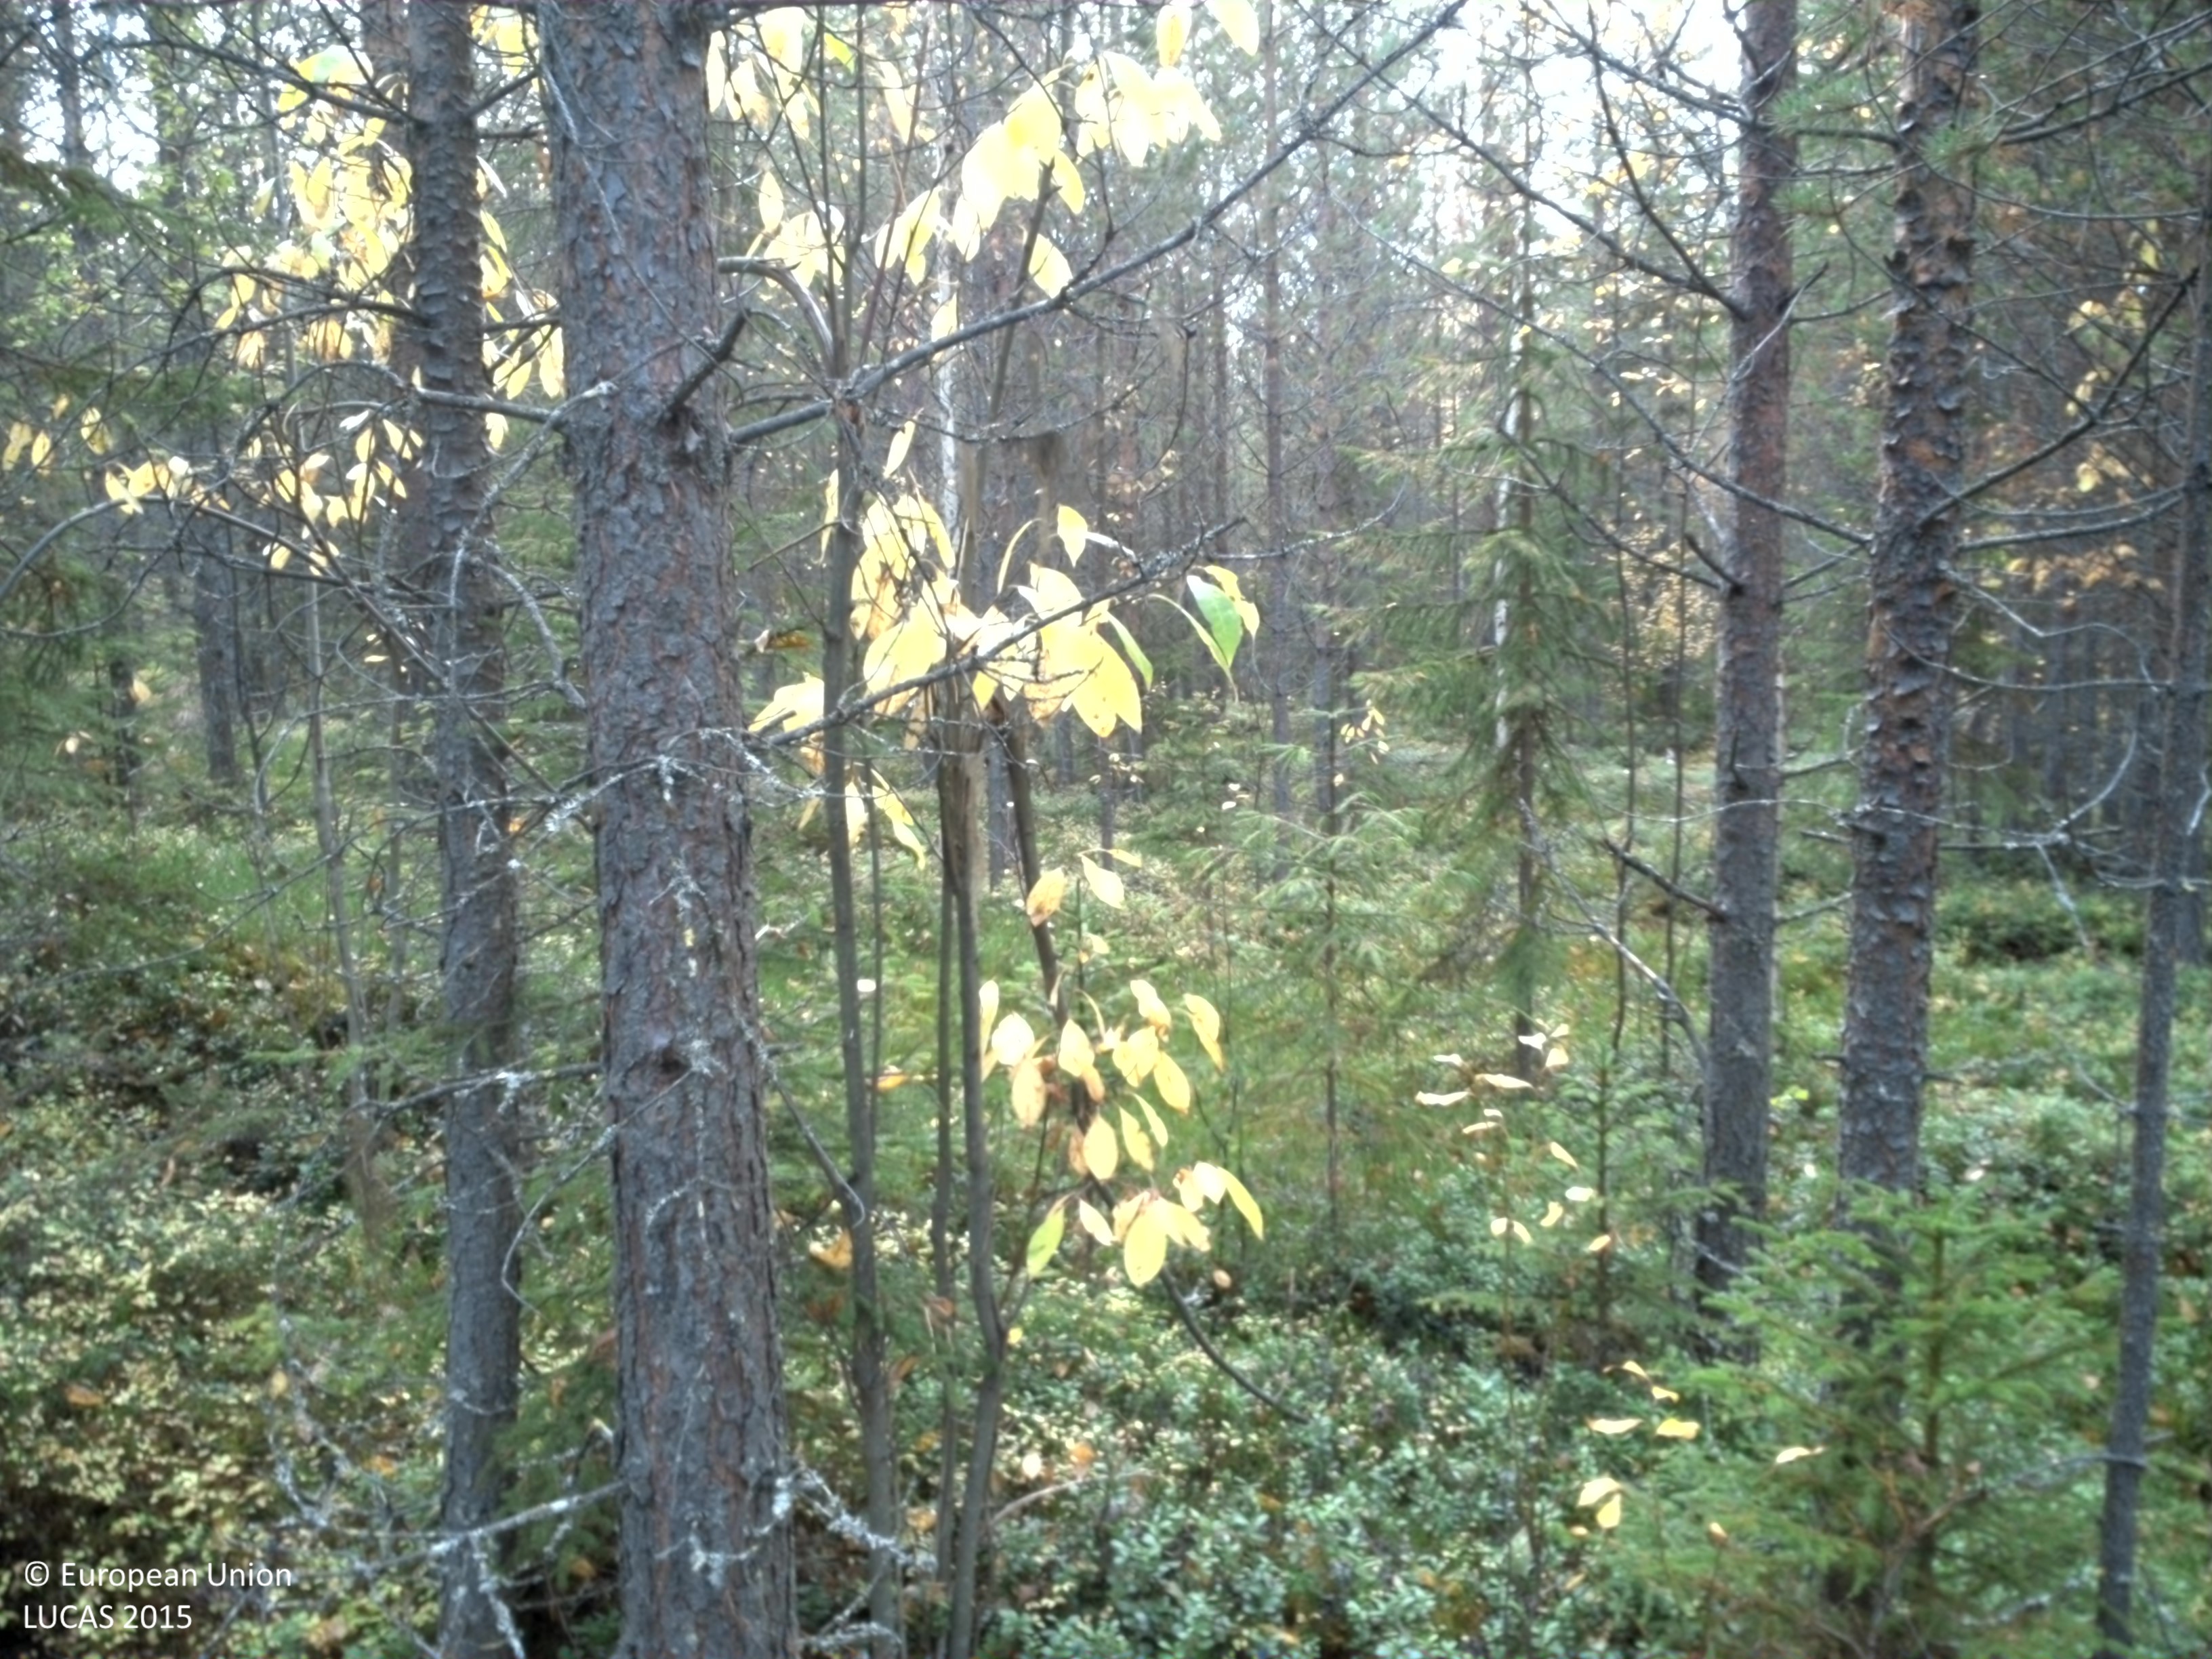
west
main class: Woodland
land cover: Pine dominated coniferous woodland
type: boreal forest
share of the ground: 25 - 50 %
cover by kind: shrubs 45 %, coniferous forest trees 35 %, lichens and mosses 15 %, broadleaved forest trees 5 %
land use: Forestry
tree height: > 5 m
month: September
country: SE
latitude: 64.9143
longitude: 17.8068
